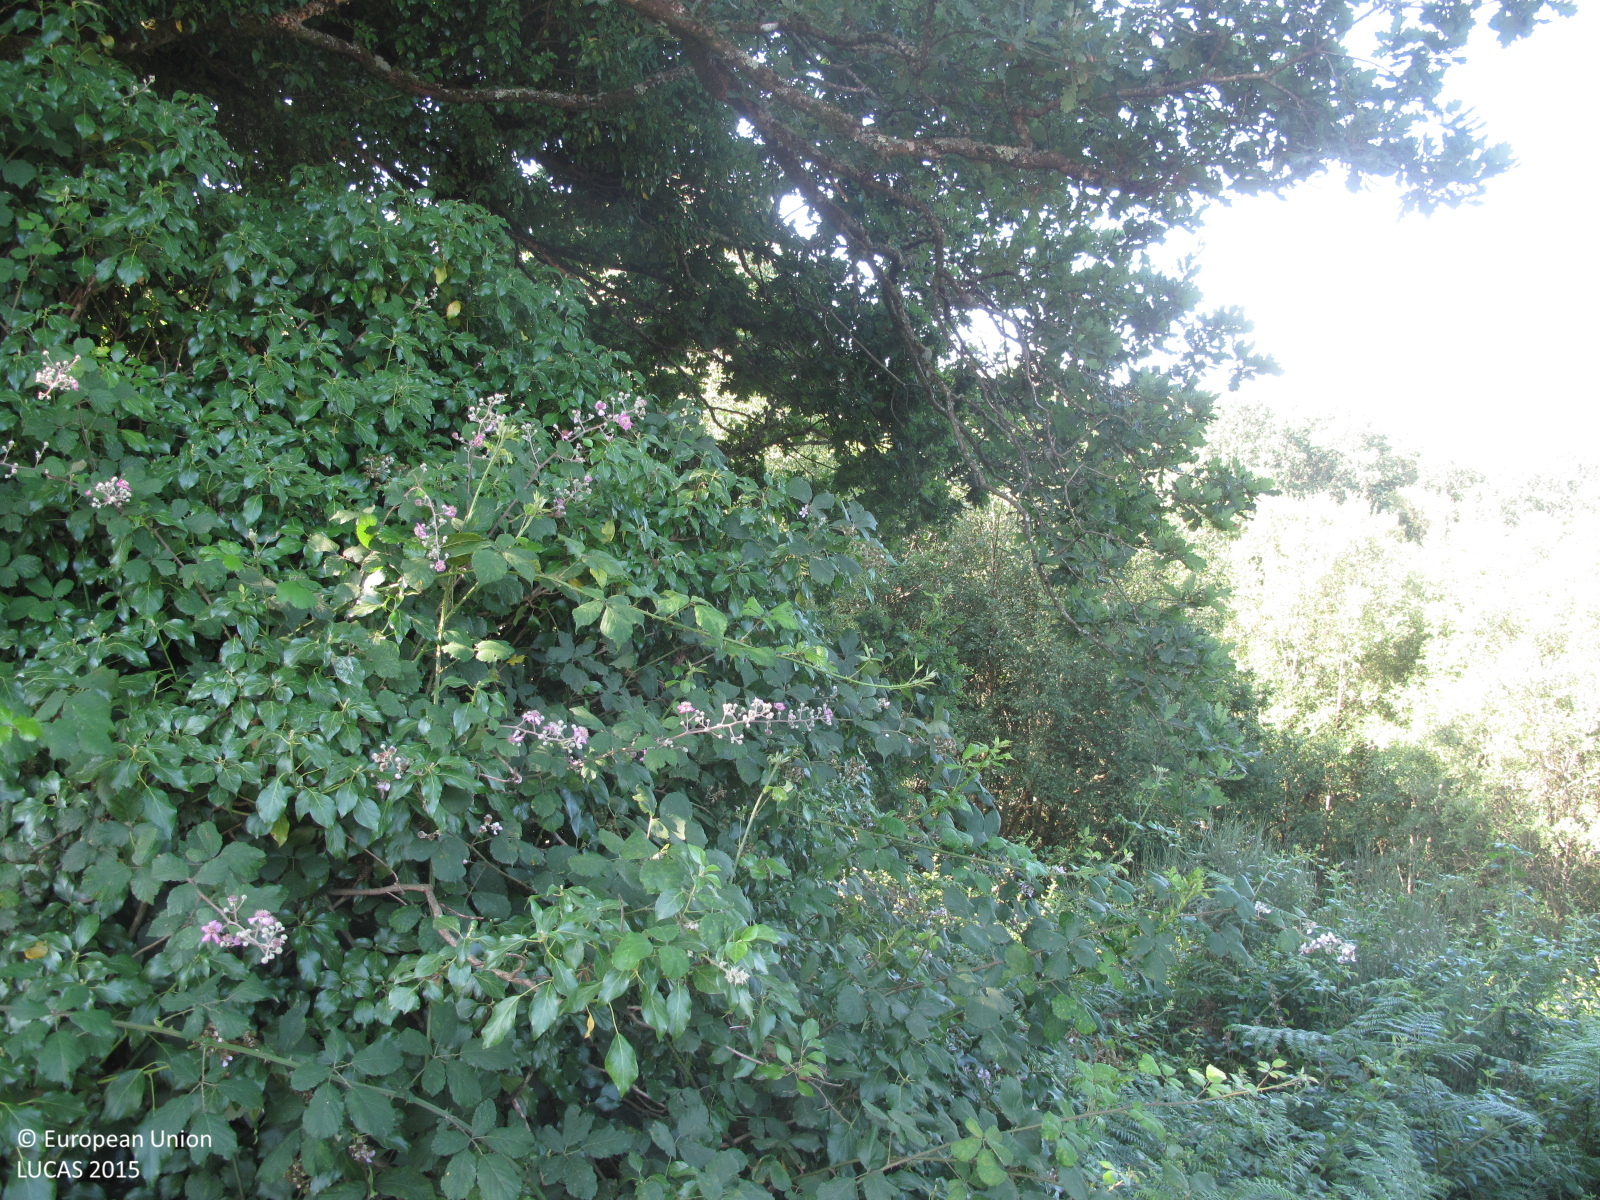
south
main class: Shrubland
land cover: Shrubland with sparse tree cover
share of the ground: > 75 %
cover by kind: shrubs 95 %, broadleaved forest trees 5 %
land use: Abandoned areas
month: July
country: ES
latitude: 43.3252
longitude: -7.9364
